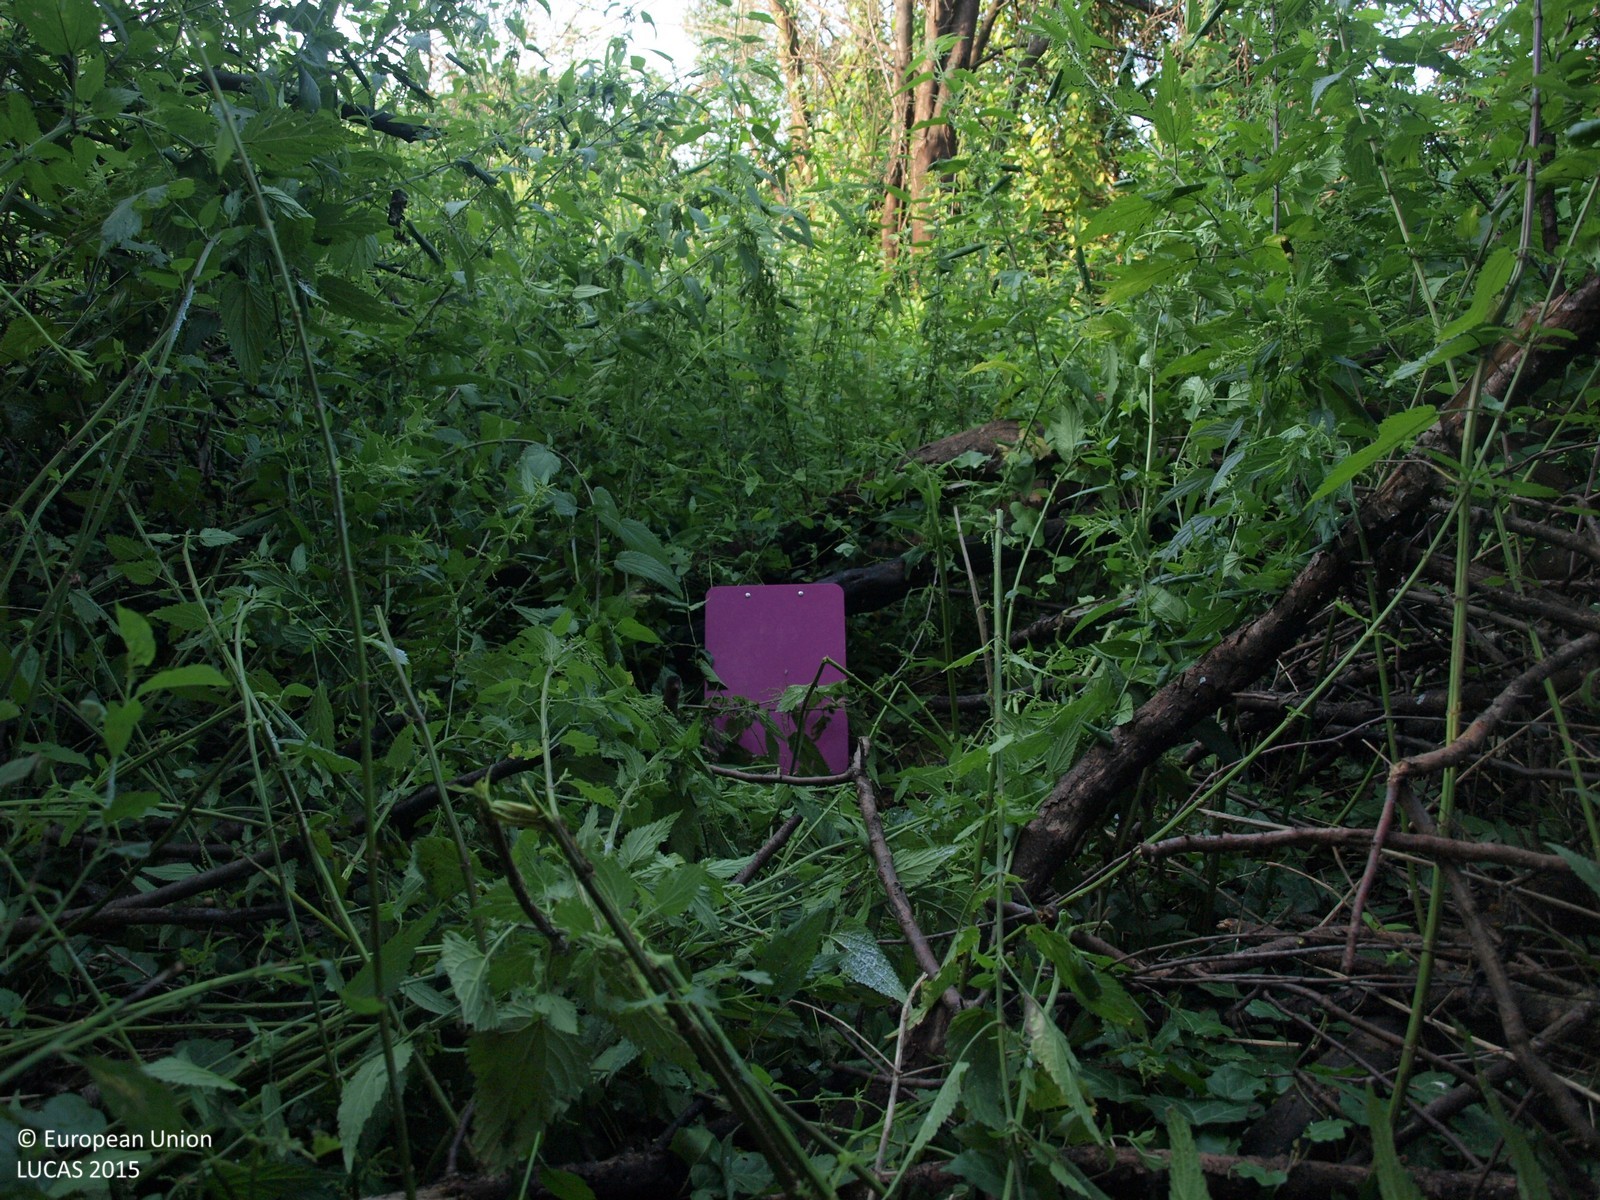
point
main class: Shrubland
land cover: Shrubland with sparse tree cover
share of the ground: > 75 %
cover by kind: shrubs 95 %, broadleaved forest trees 5 %
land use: Semi-natural and natural areas not in use
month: August
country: HR
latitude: 45.9692
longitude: 16.2580
